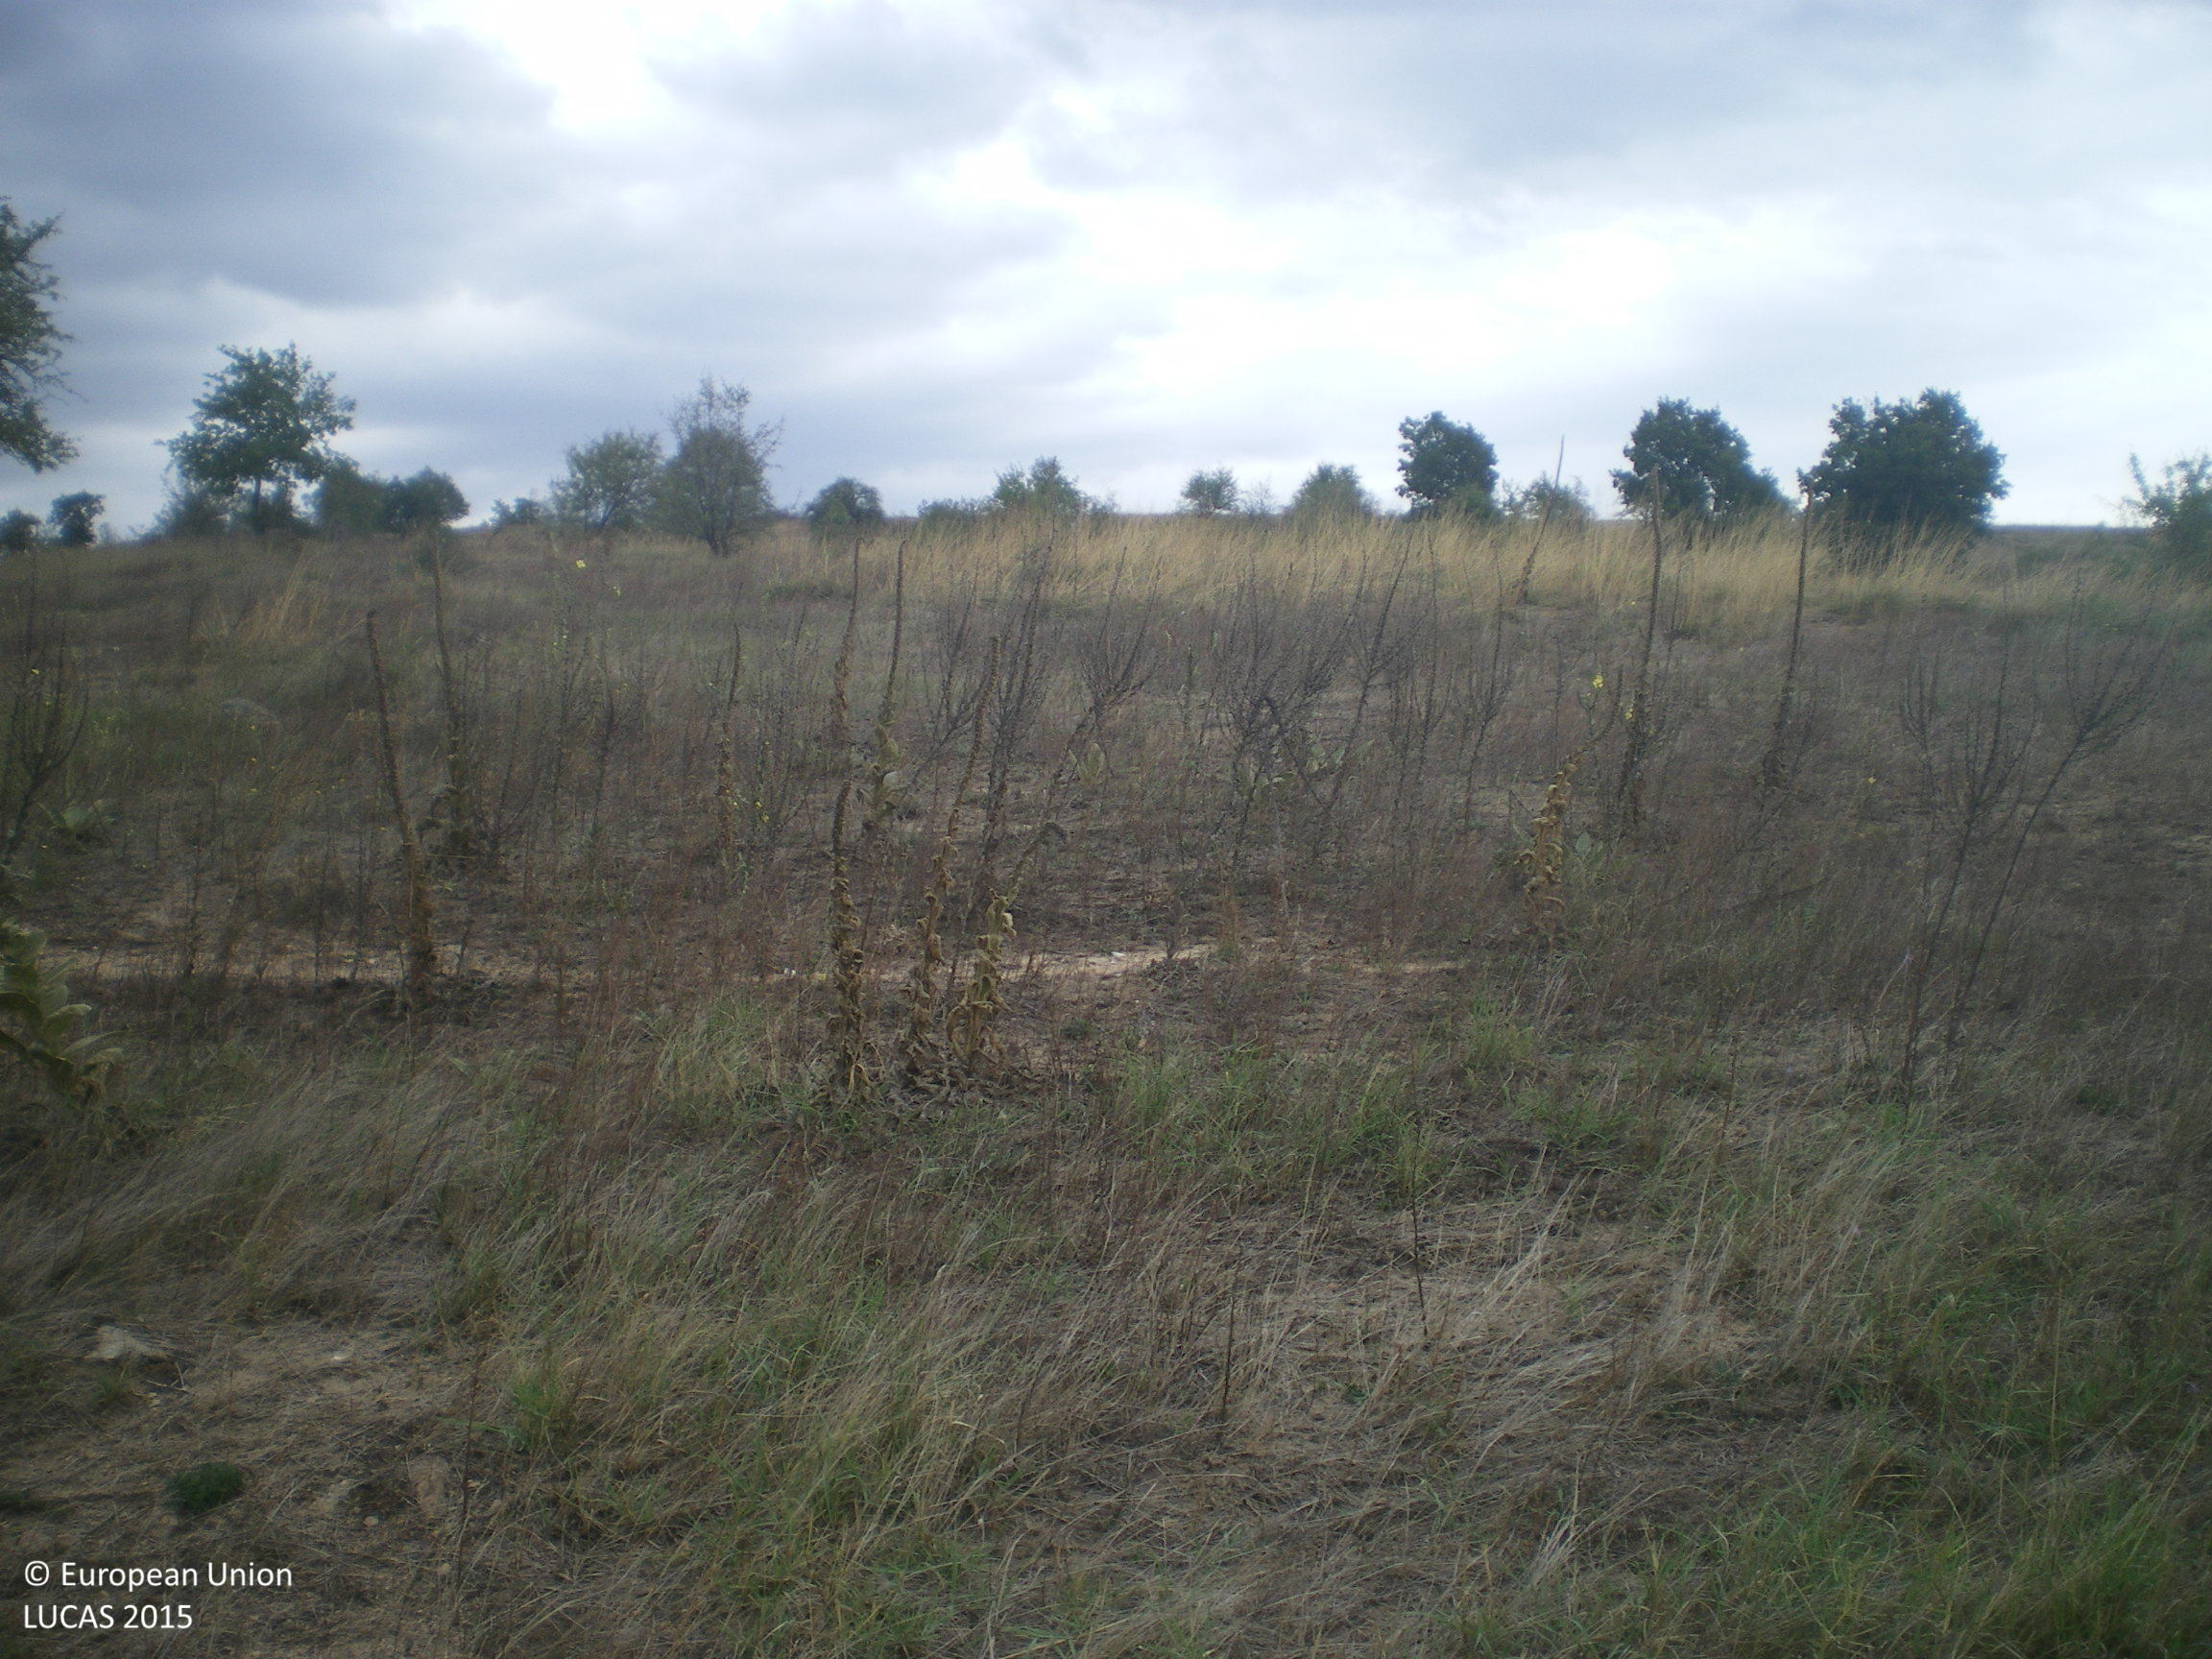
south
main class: Grassland
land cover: Grassland with sparse tree/shrub cover
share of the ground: > 75 %
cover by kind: herbaceous plants 95 %, broadleaved forest trees 5 %
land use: Semi-natural and natural areas not in use
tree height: > 5 m
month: September
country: BG
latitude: 41.9662
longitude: 25.9647
